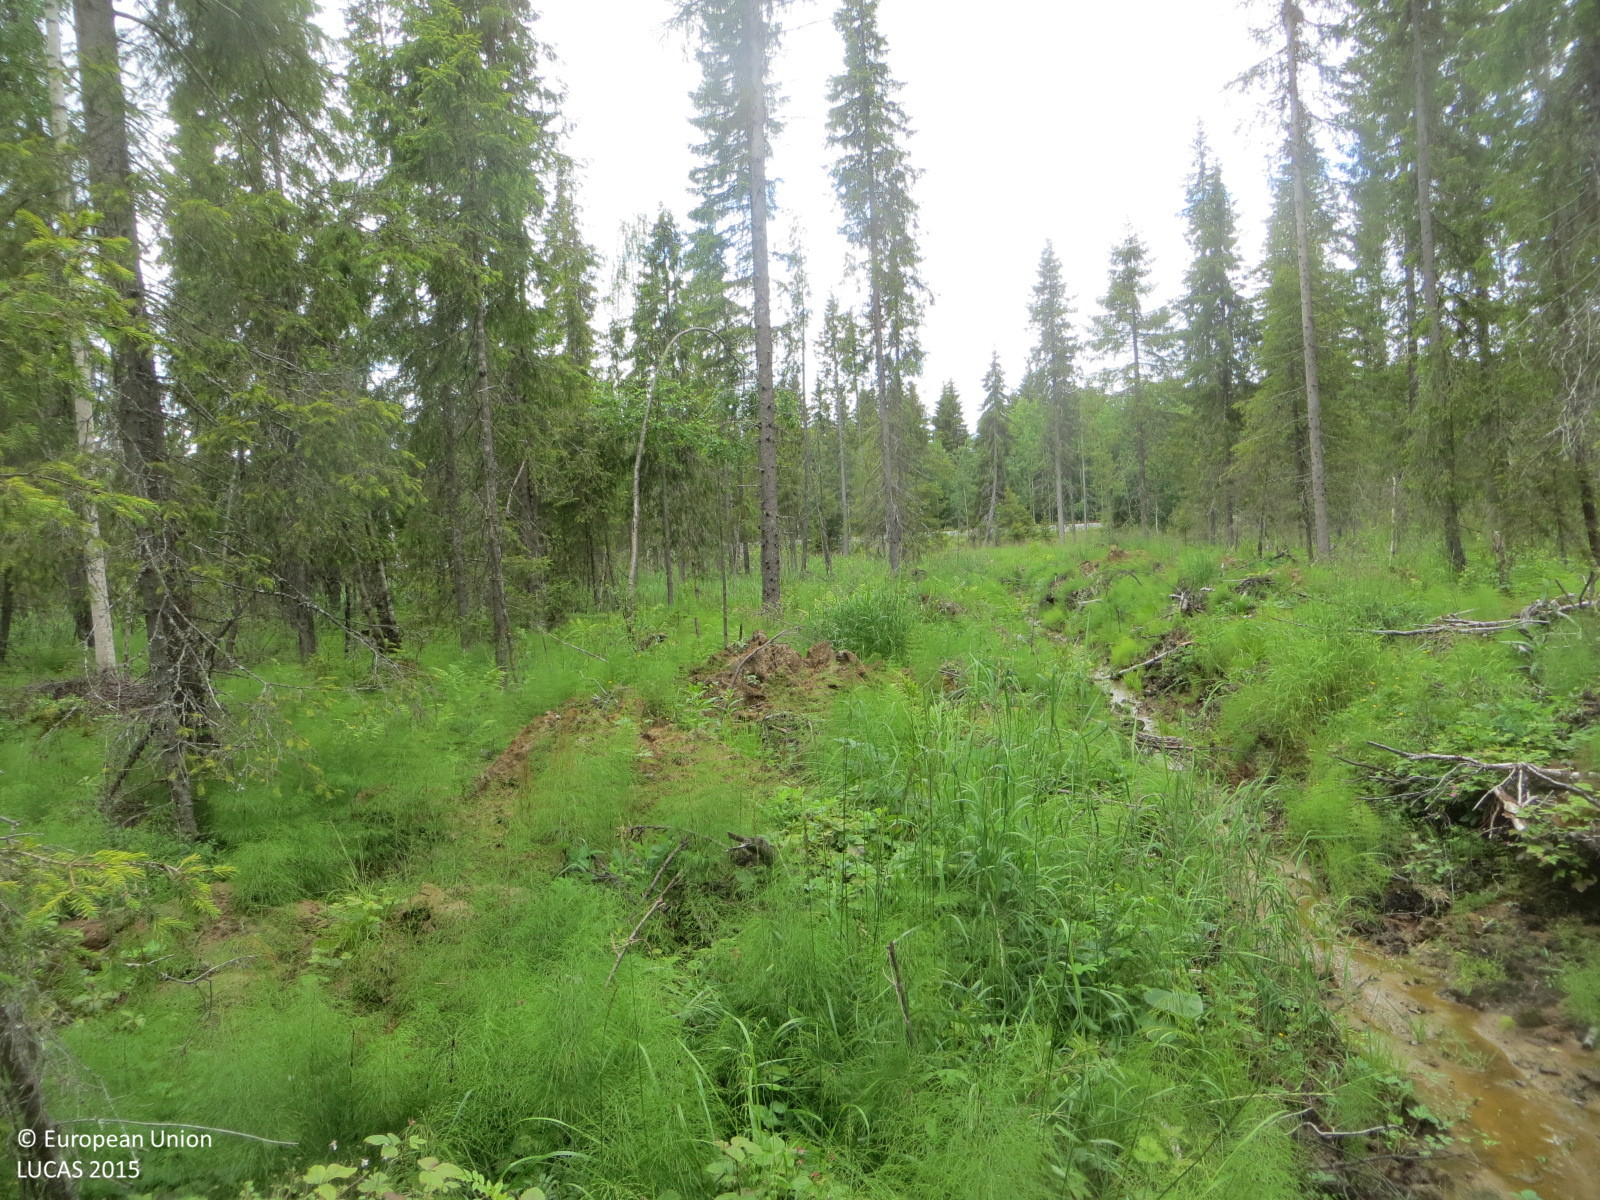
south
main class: Woodland
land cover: Spruce dominated coniferous woodland
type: boreal forest
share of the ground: 50 - 75 %
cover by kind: coniferous forest trees 60 %, shrubs 35 %, broadleaved forest trees 5 %
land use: Forestry
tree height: > 5 m
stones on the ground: < 10 %
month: July
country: FI
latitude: 66.1555
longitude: 23.9393
